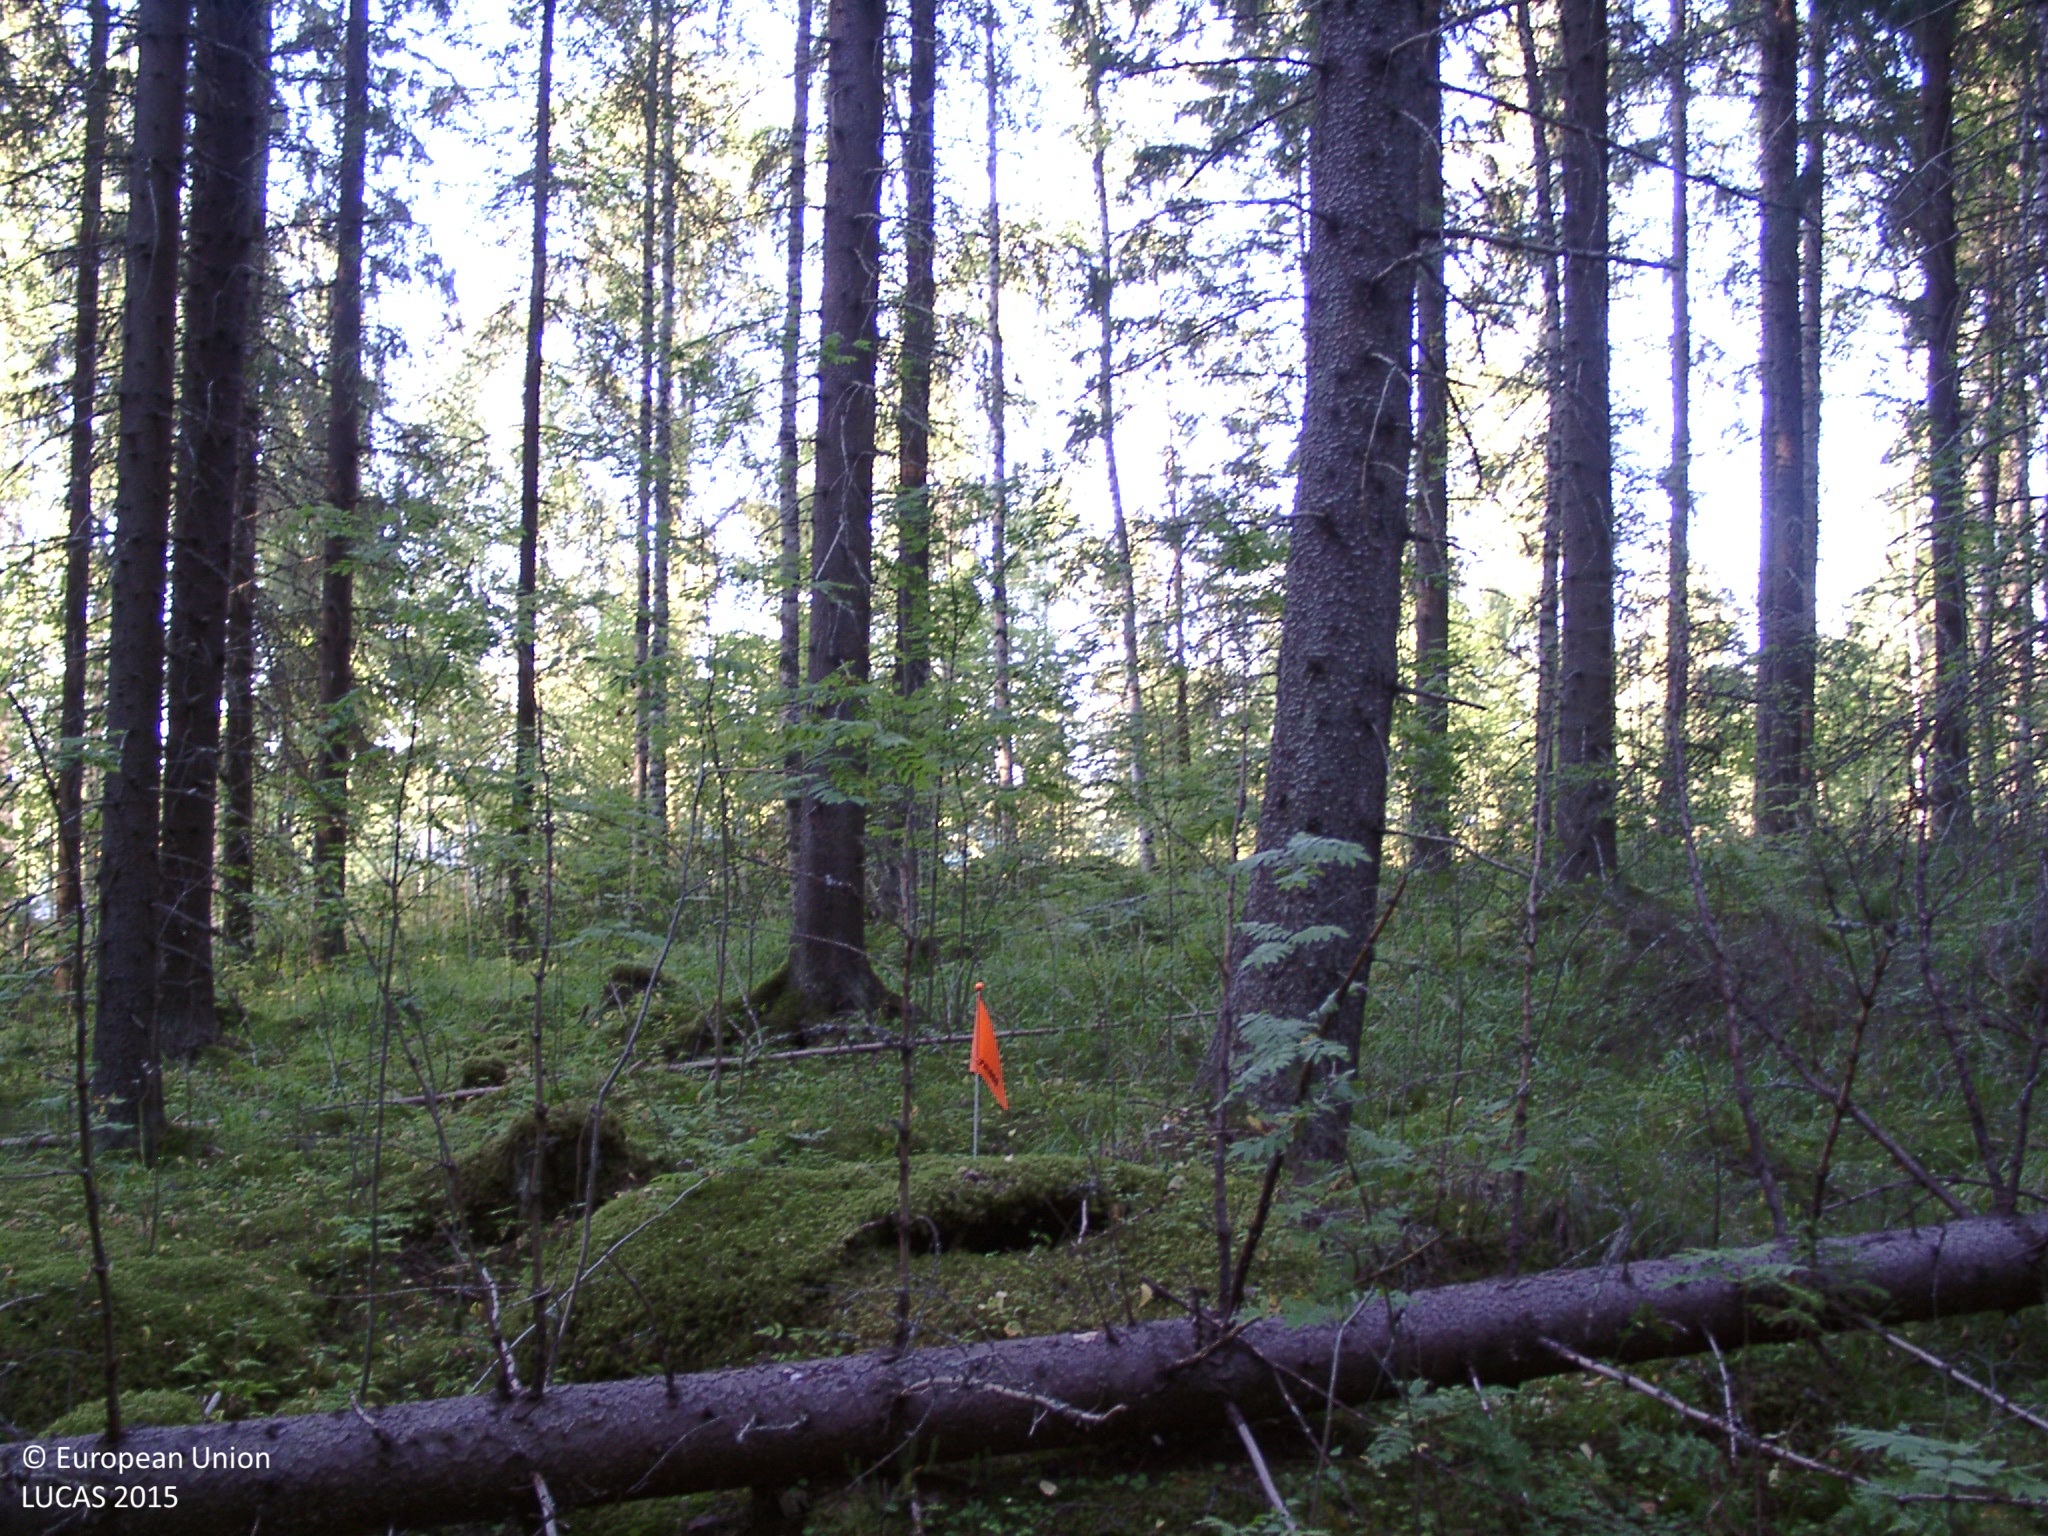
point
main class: Woodland
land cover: Spruce dominated coniferous woodland
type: boreal forest
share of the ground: > 75 %
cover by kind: coniferous forest trees 75 %, broadleaved forest trees 10 %, lichens and mosses 10 %, herbaceous plants 5 %
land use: Forestry
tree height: > 5 m
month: August
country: FI
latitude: 62.0002
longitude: 25.0177
